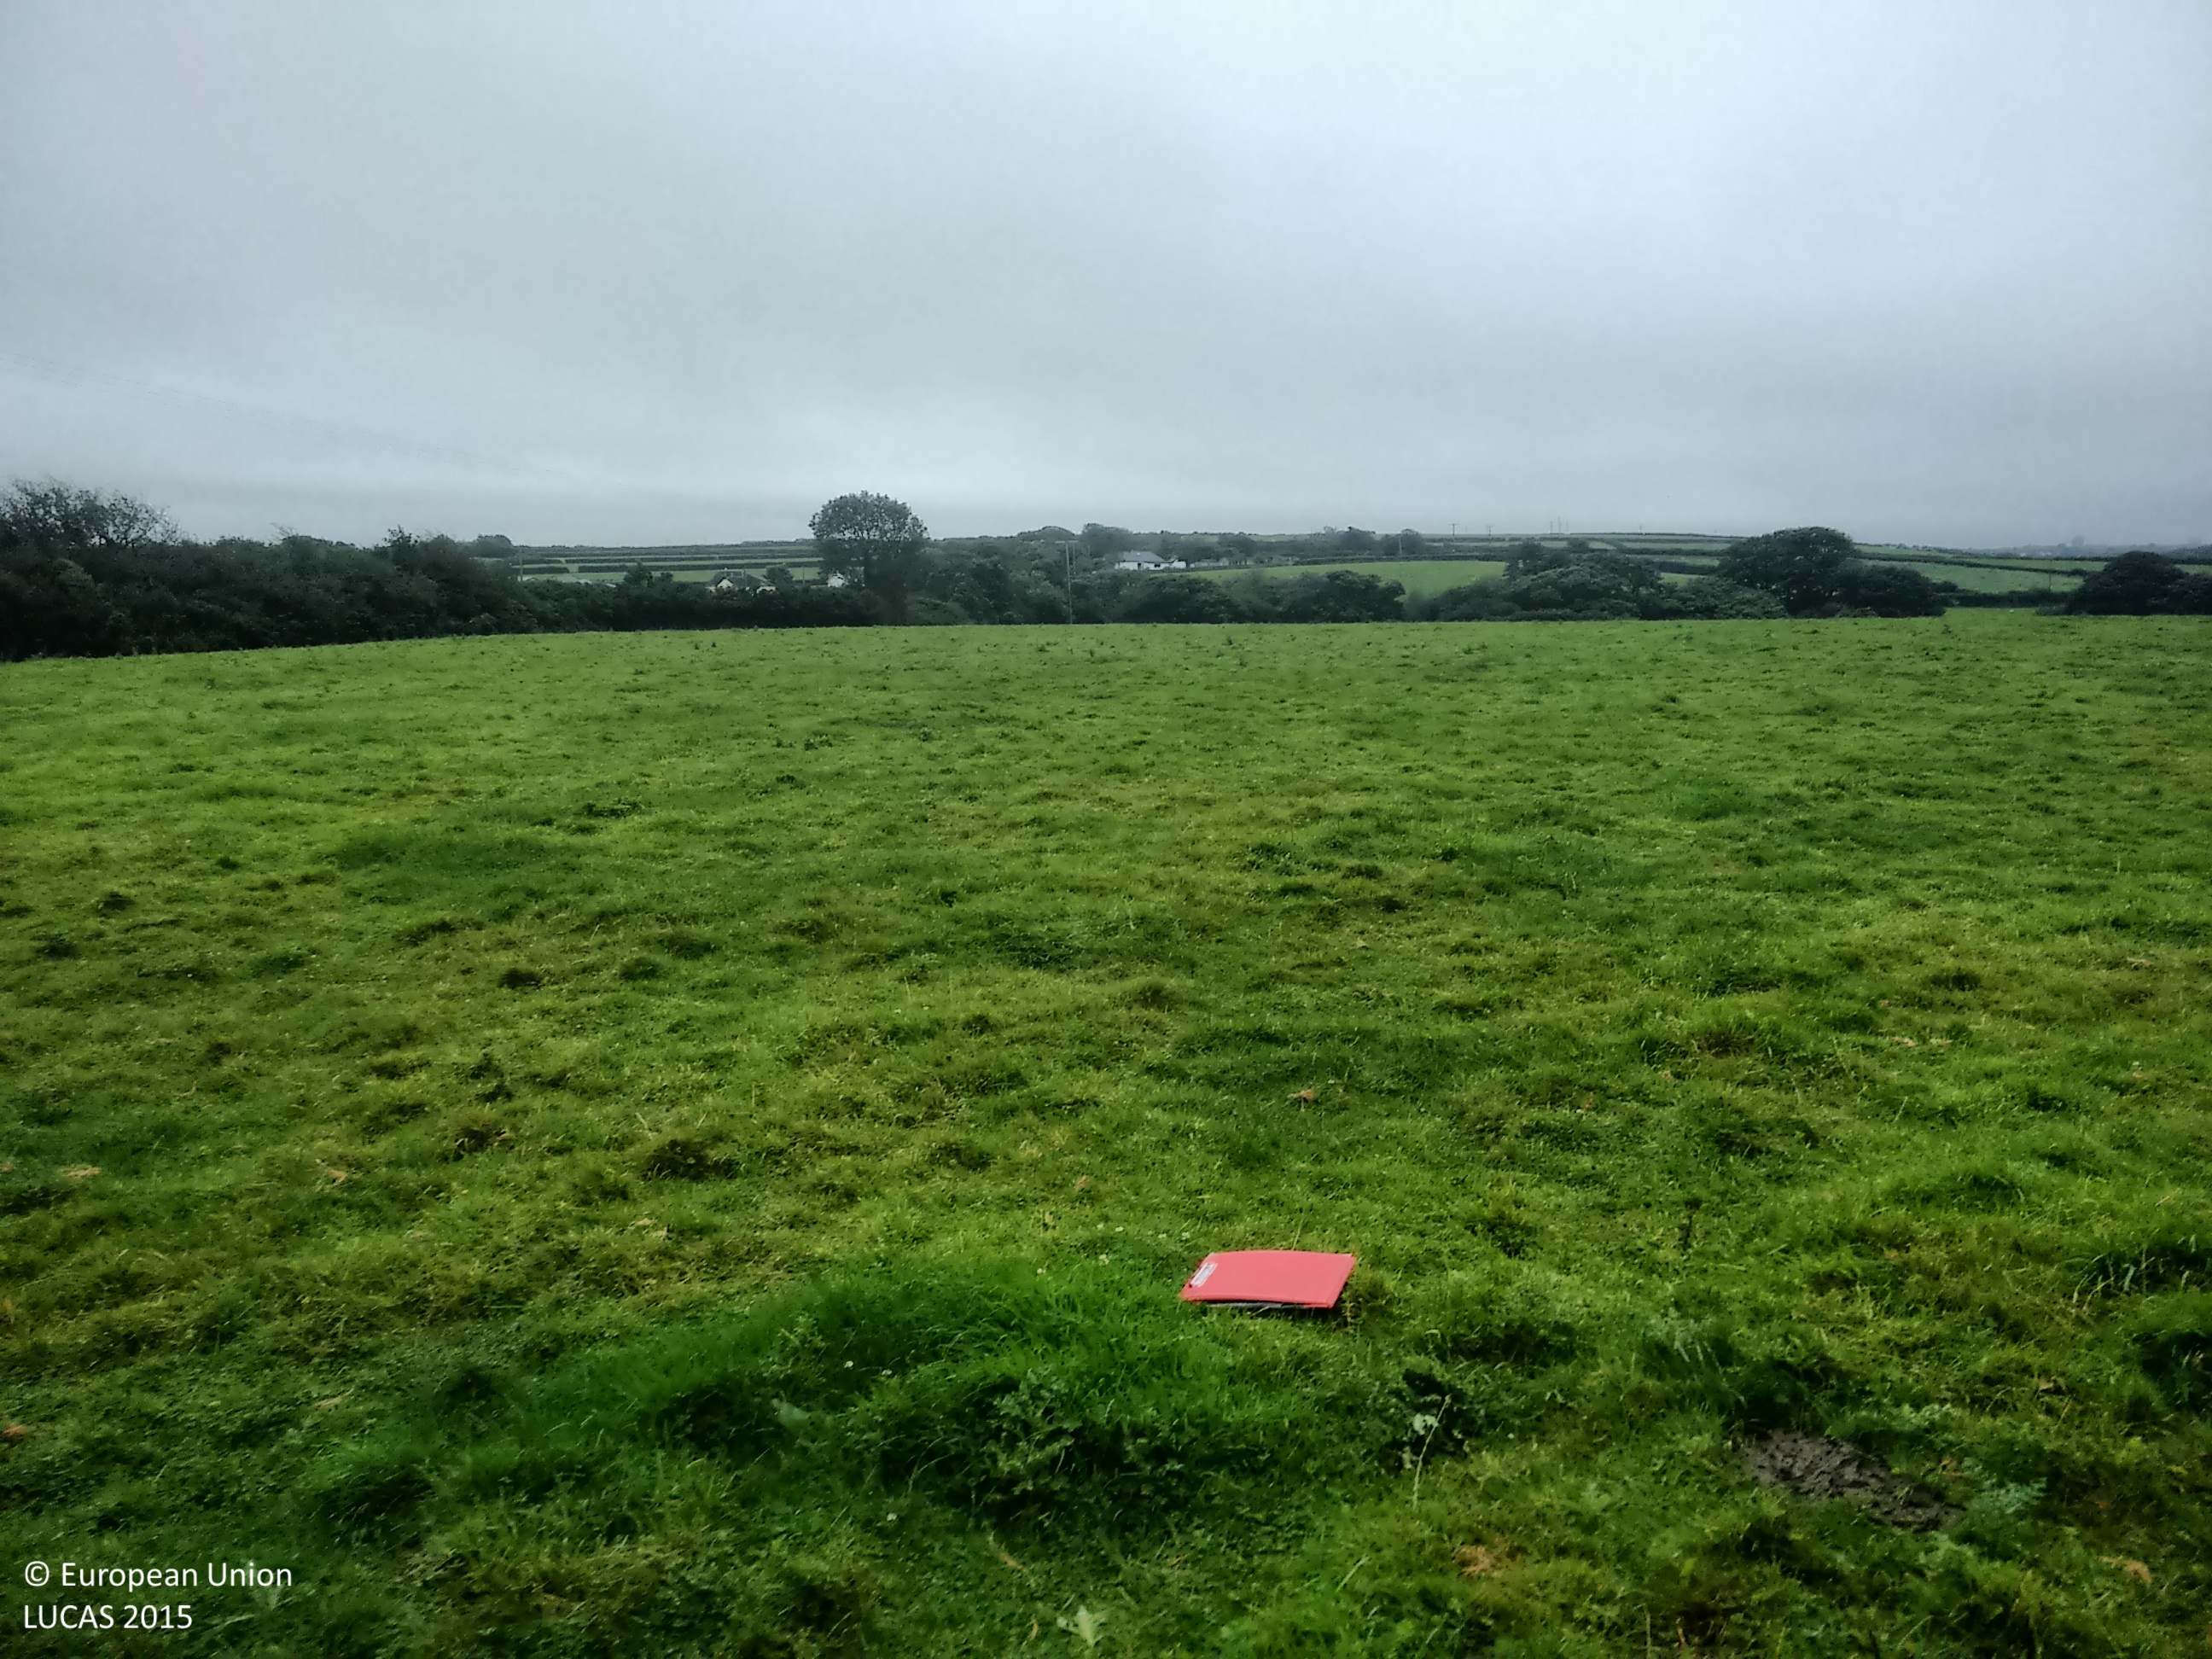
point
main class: Grassland
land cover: Grassland without tree/shrub cover
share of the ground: > 75 %
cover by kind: herbaceous plants 100 %
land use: Agriculture (excluding fallow land and kitchen gardens)
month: August
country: GB
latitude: 50.0803
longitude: -5.1411
